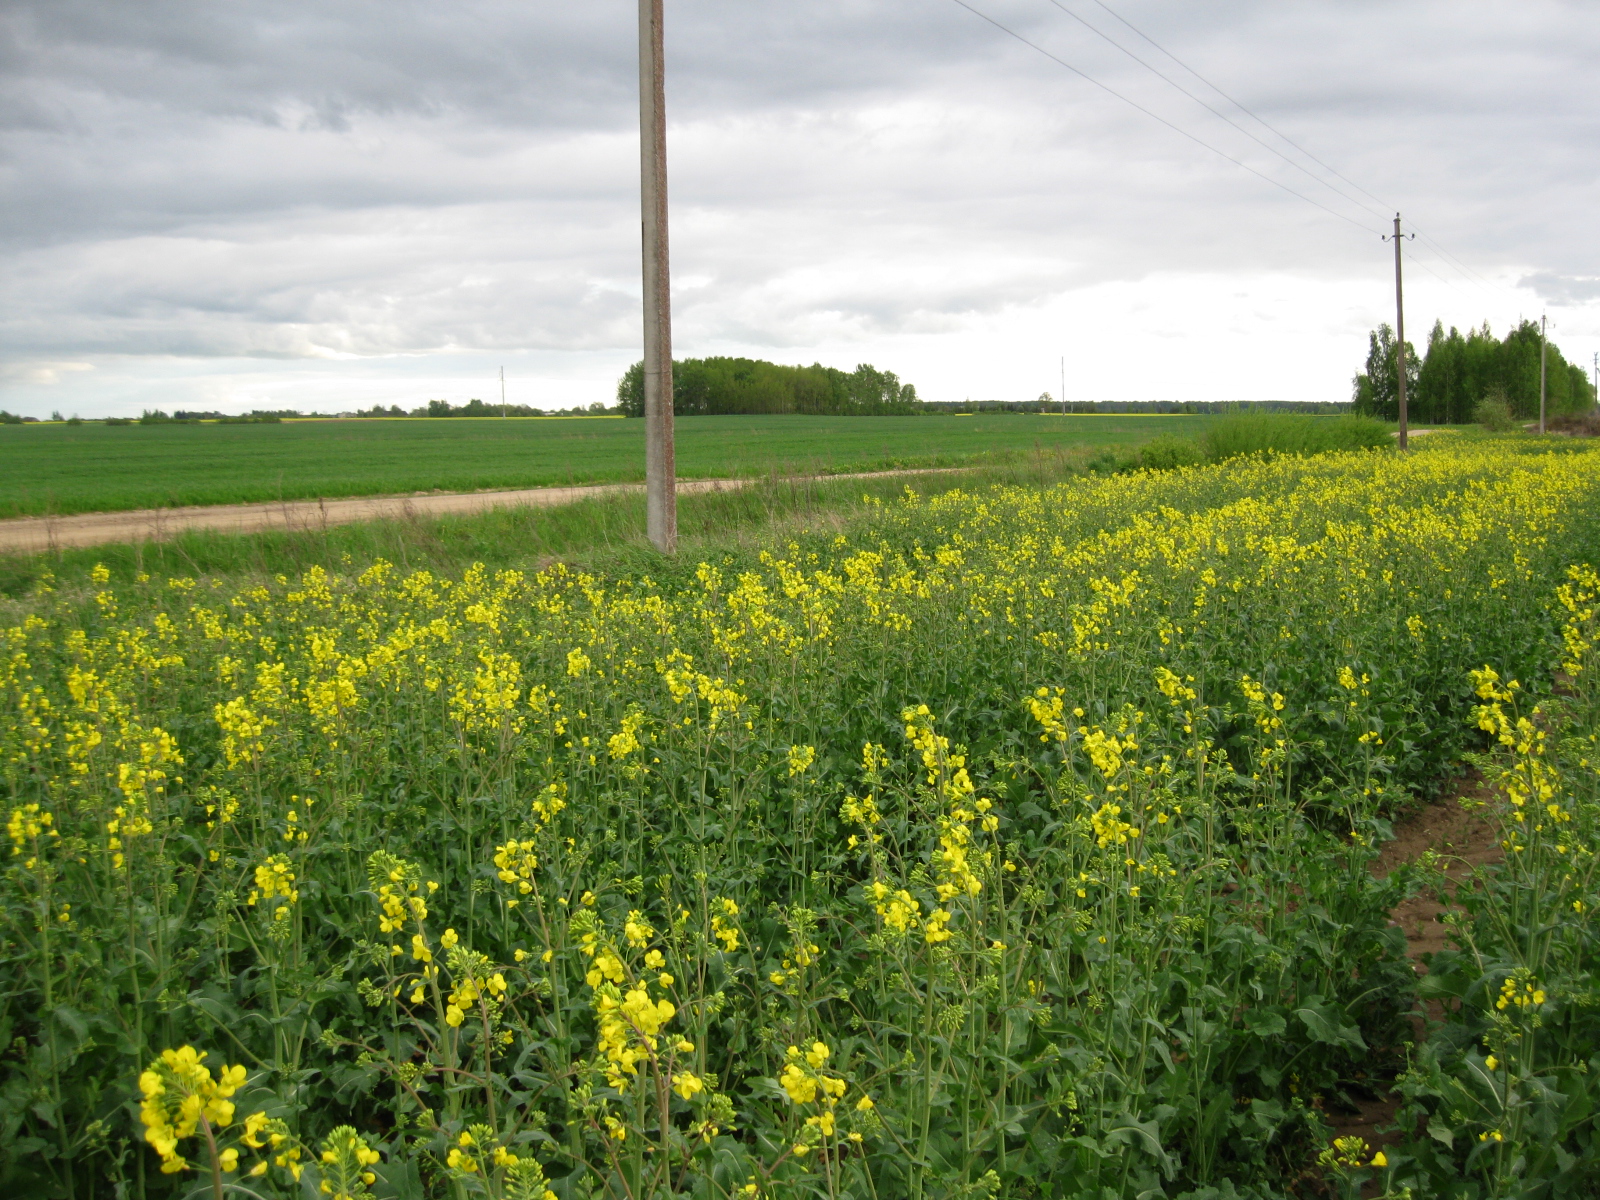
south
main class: Cropland
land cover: Rape and turnip rape
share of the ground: > 75 %
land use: Agriculture (excluding fallow land and kitchen gardens)
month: May
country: LT
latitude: 56.2806
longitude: 23.4325
